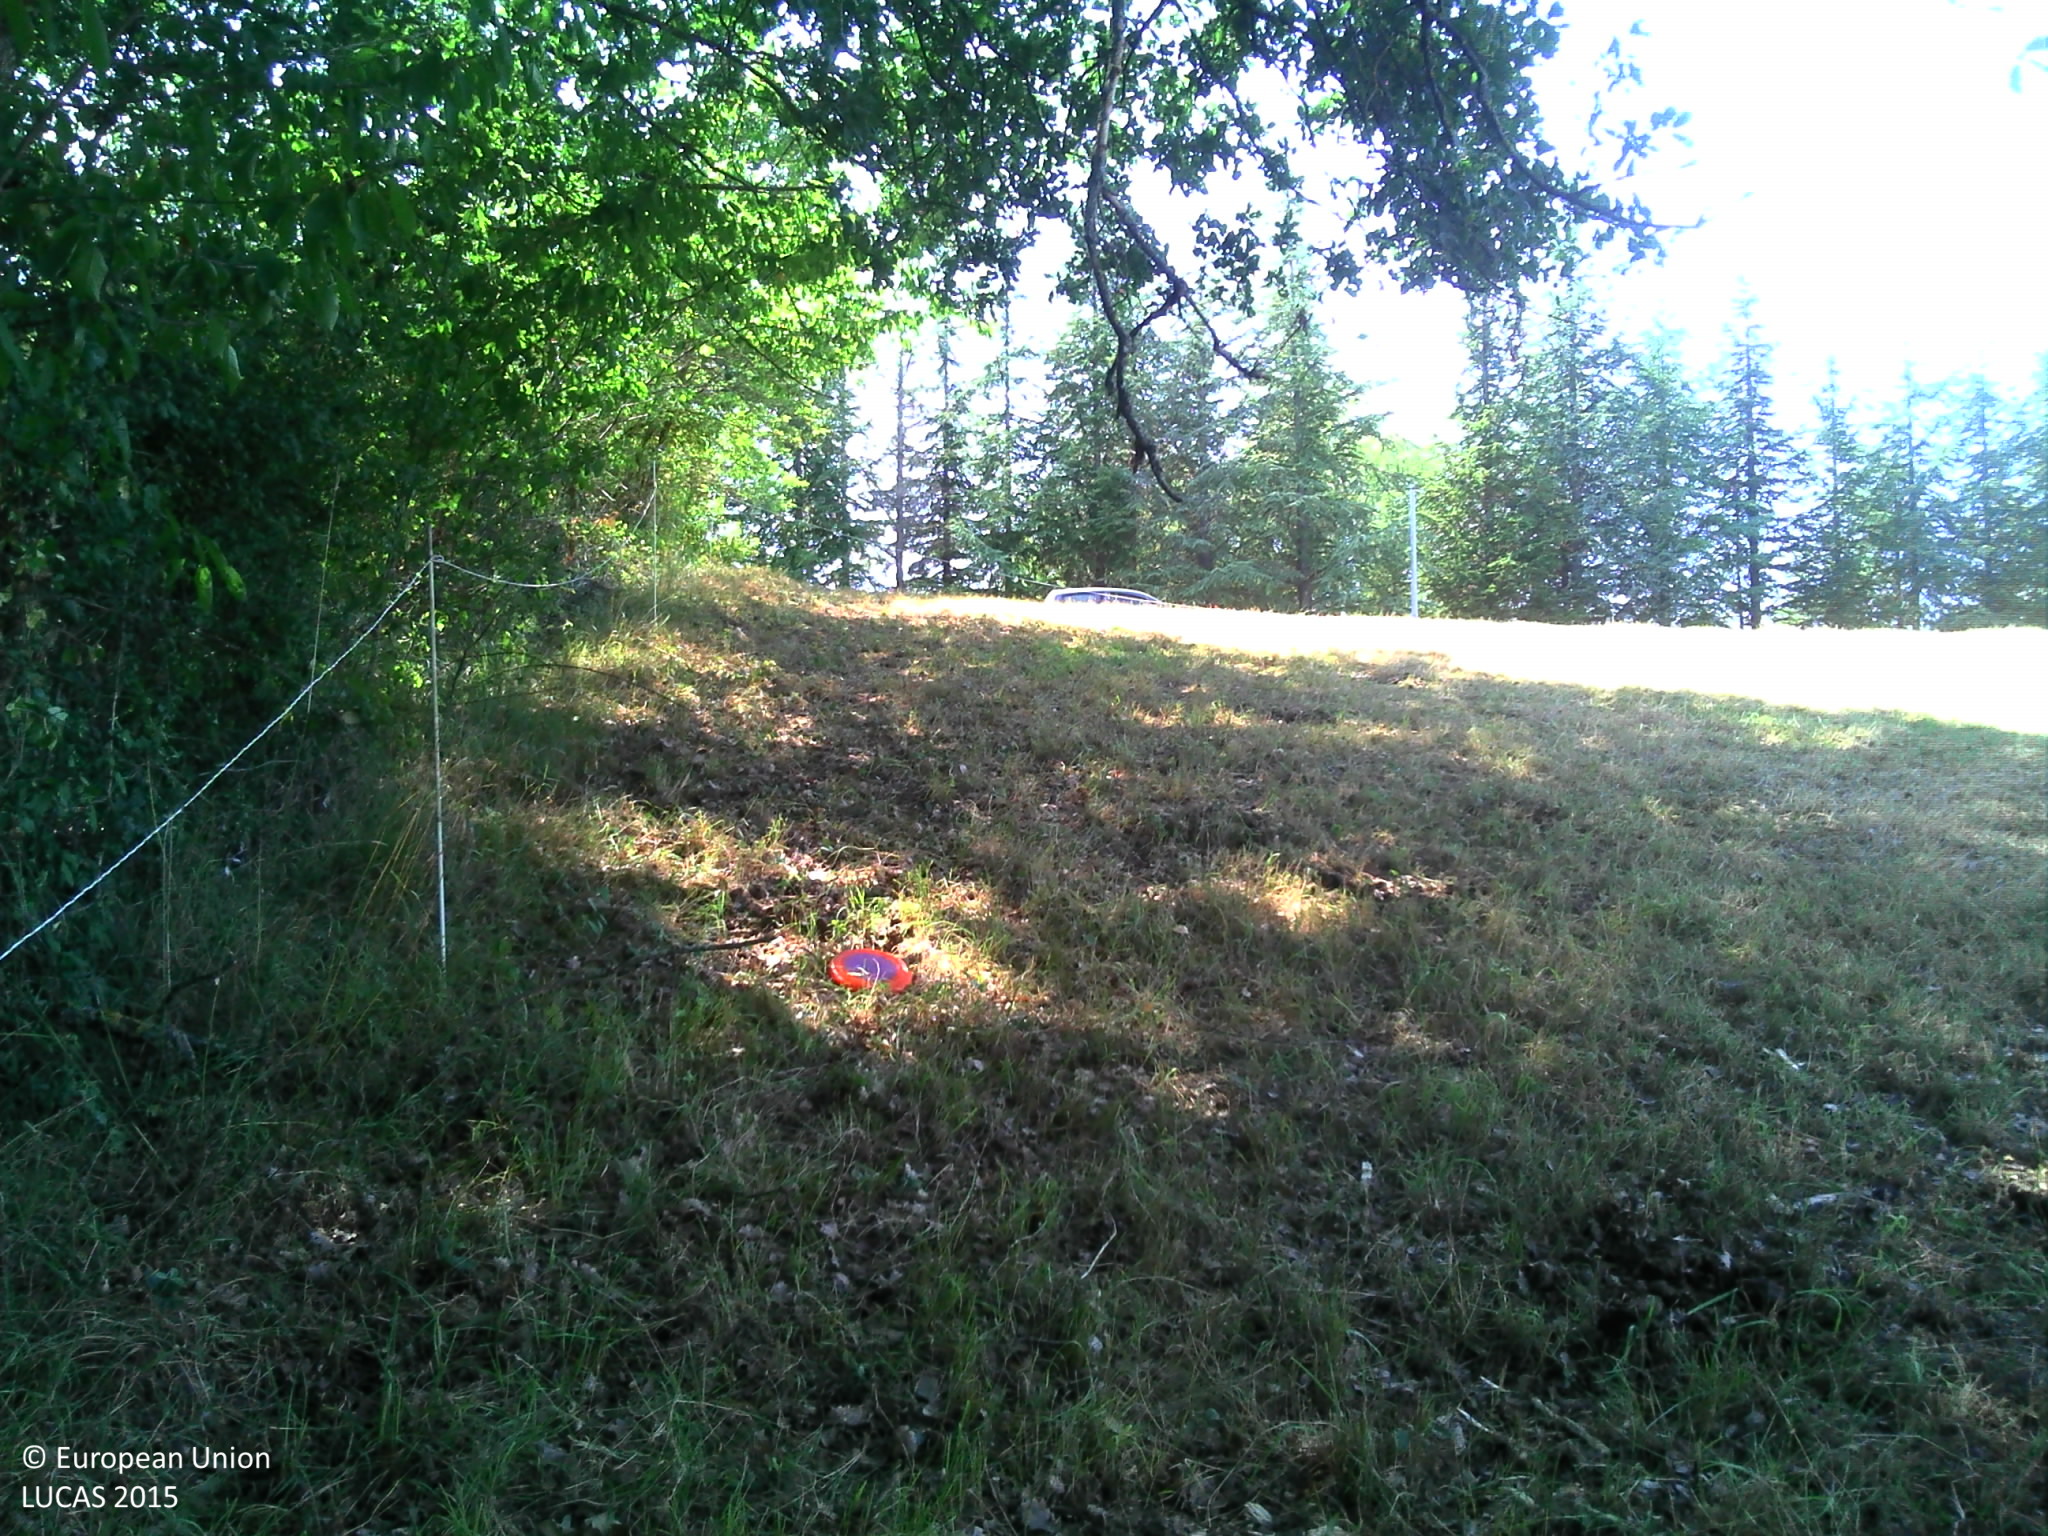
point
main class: Grassland
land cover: Grassland without tree/shrub cover
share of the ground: > 75 %
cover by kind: herbaceous plants 100 %
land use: Agriculture (excluding fallow land and kitchen gardens)
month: July
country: FR
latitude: 43.1765
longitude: 1.1833
